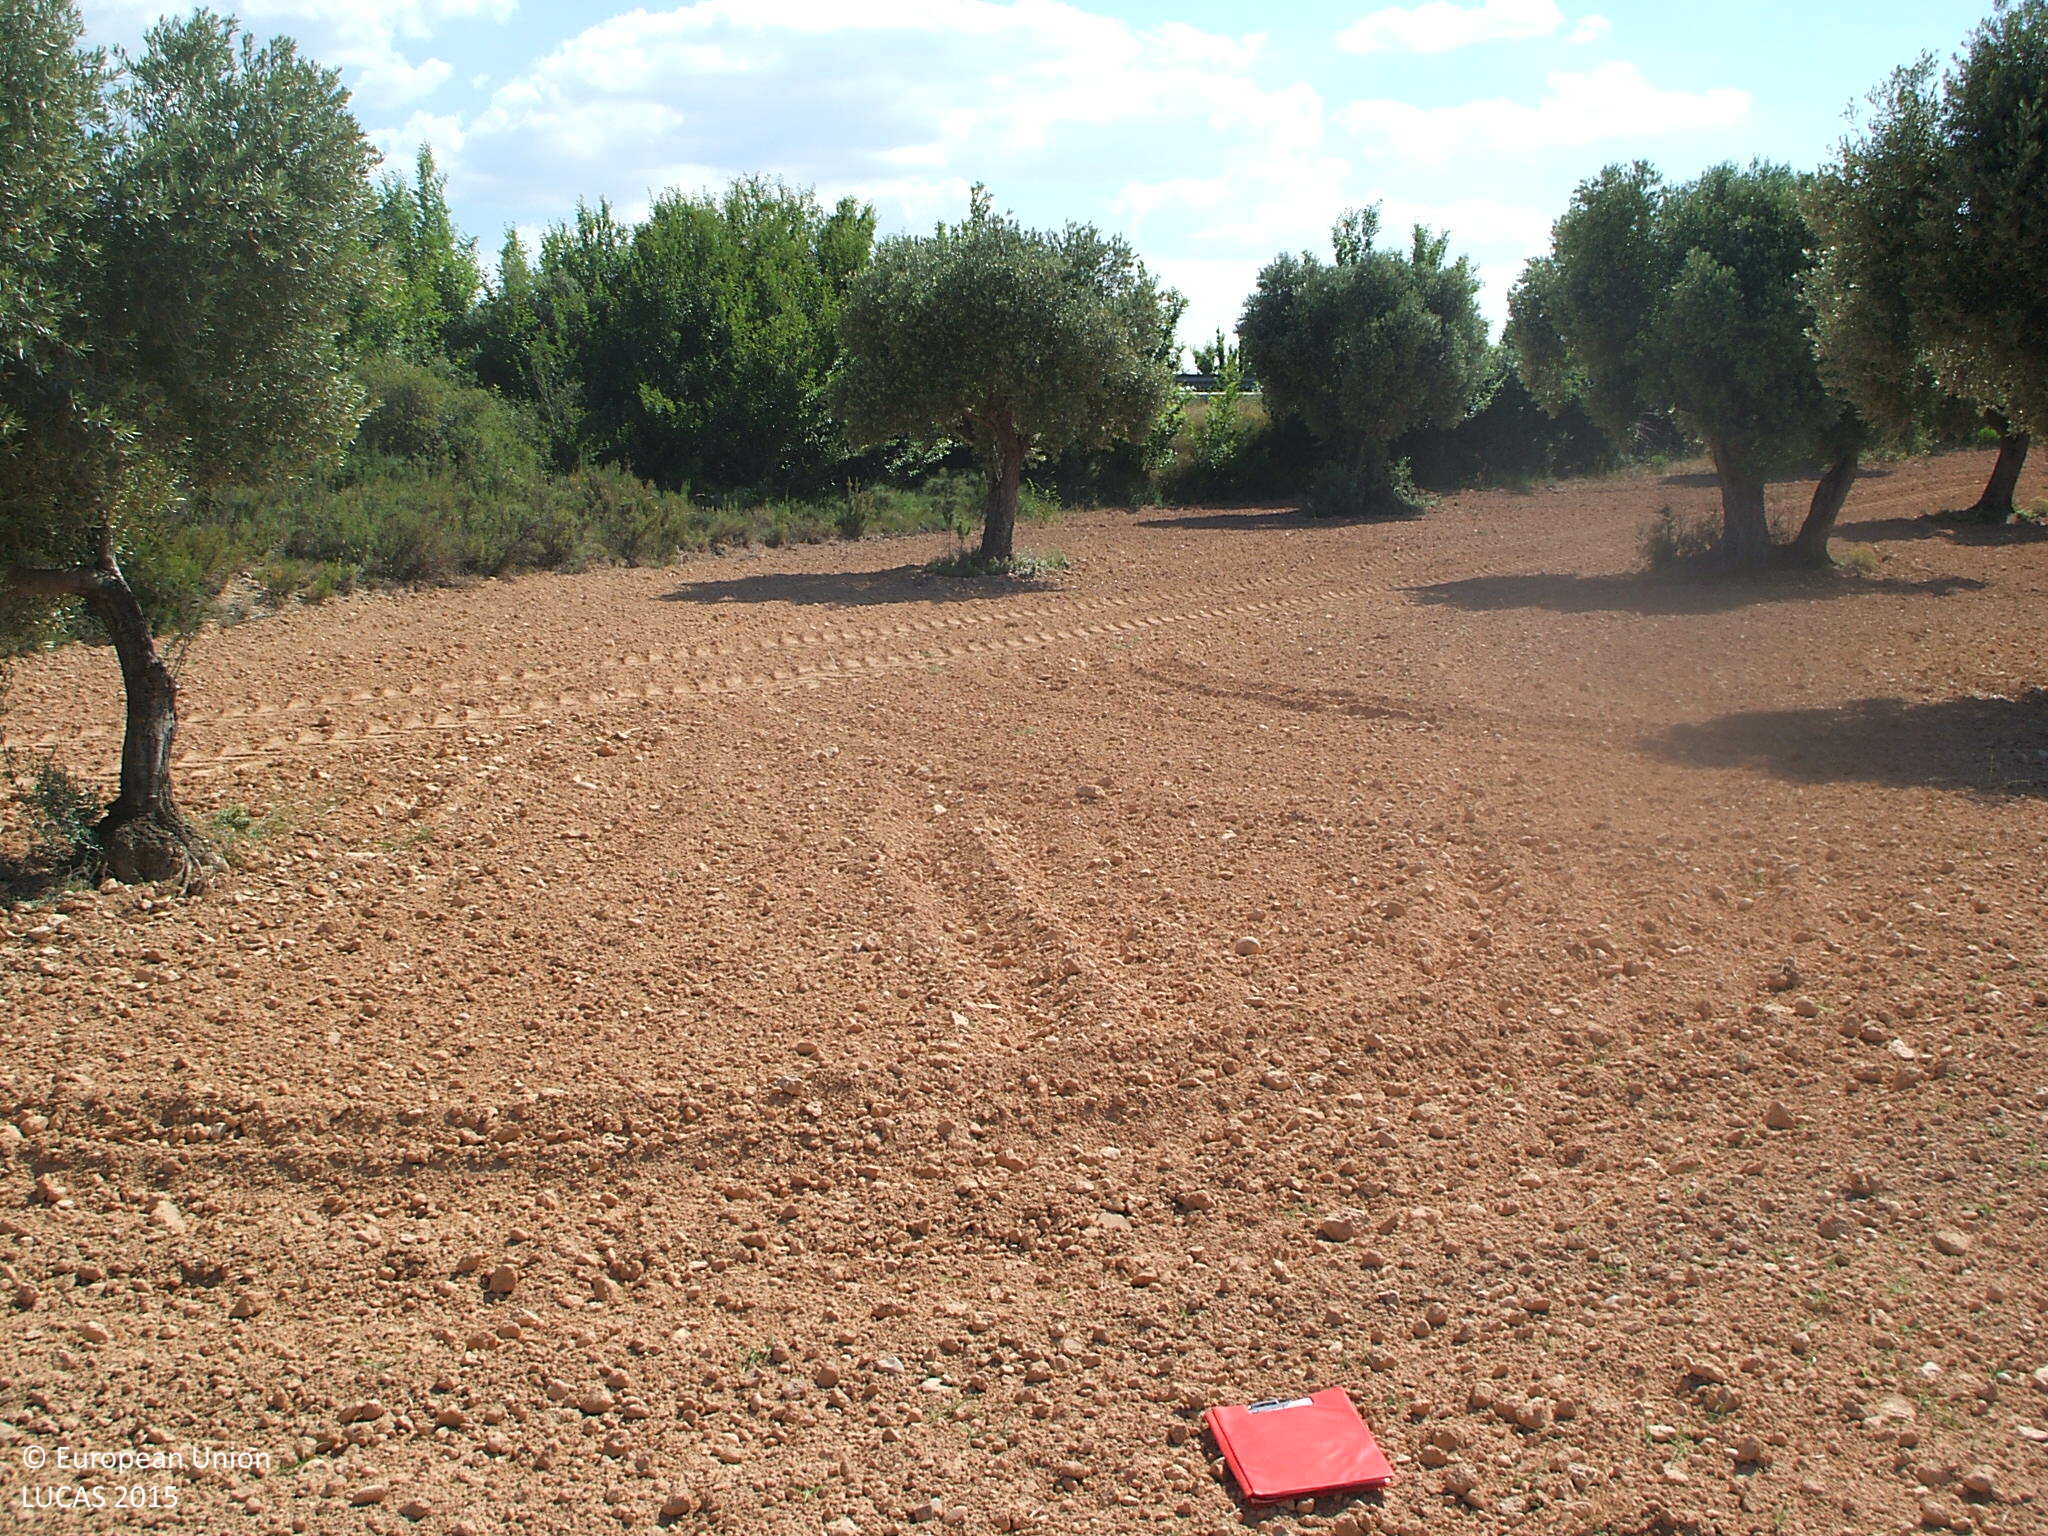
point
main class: Cropland
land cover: Olive groves
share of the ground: 10 - 25 %
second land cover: Other bare soil
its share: > 75 %
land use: Agriculture (excluding fallow land and kitchen gardens)
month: June
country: ES
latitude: 40.9725
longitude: -0.0280
